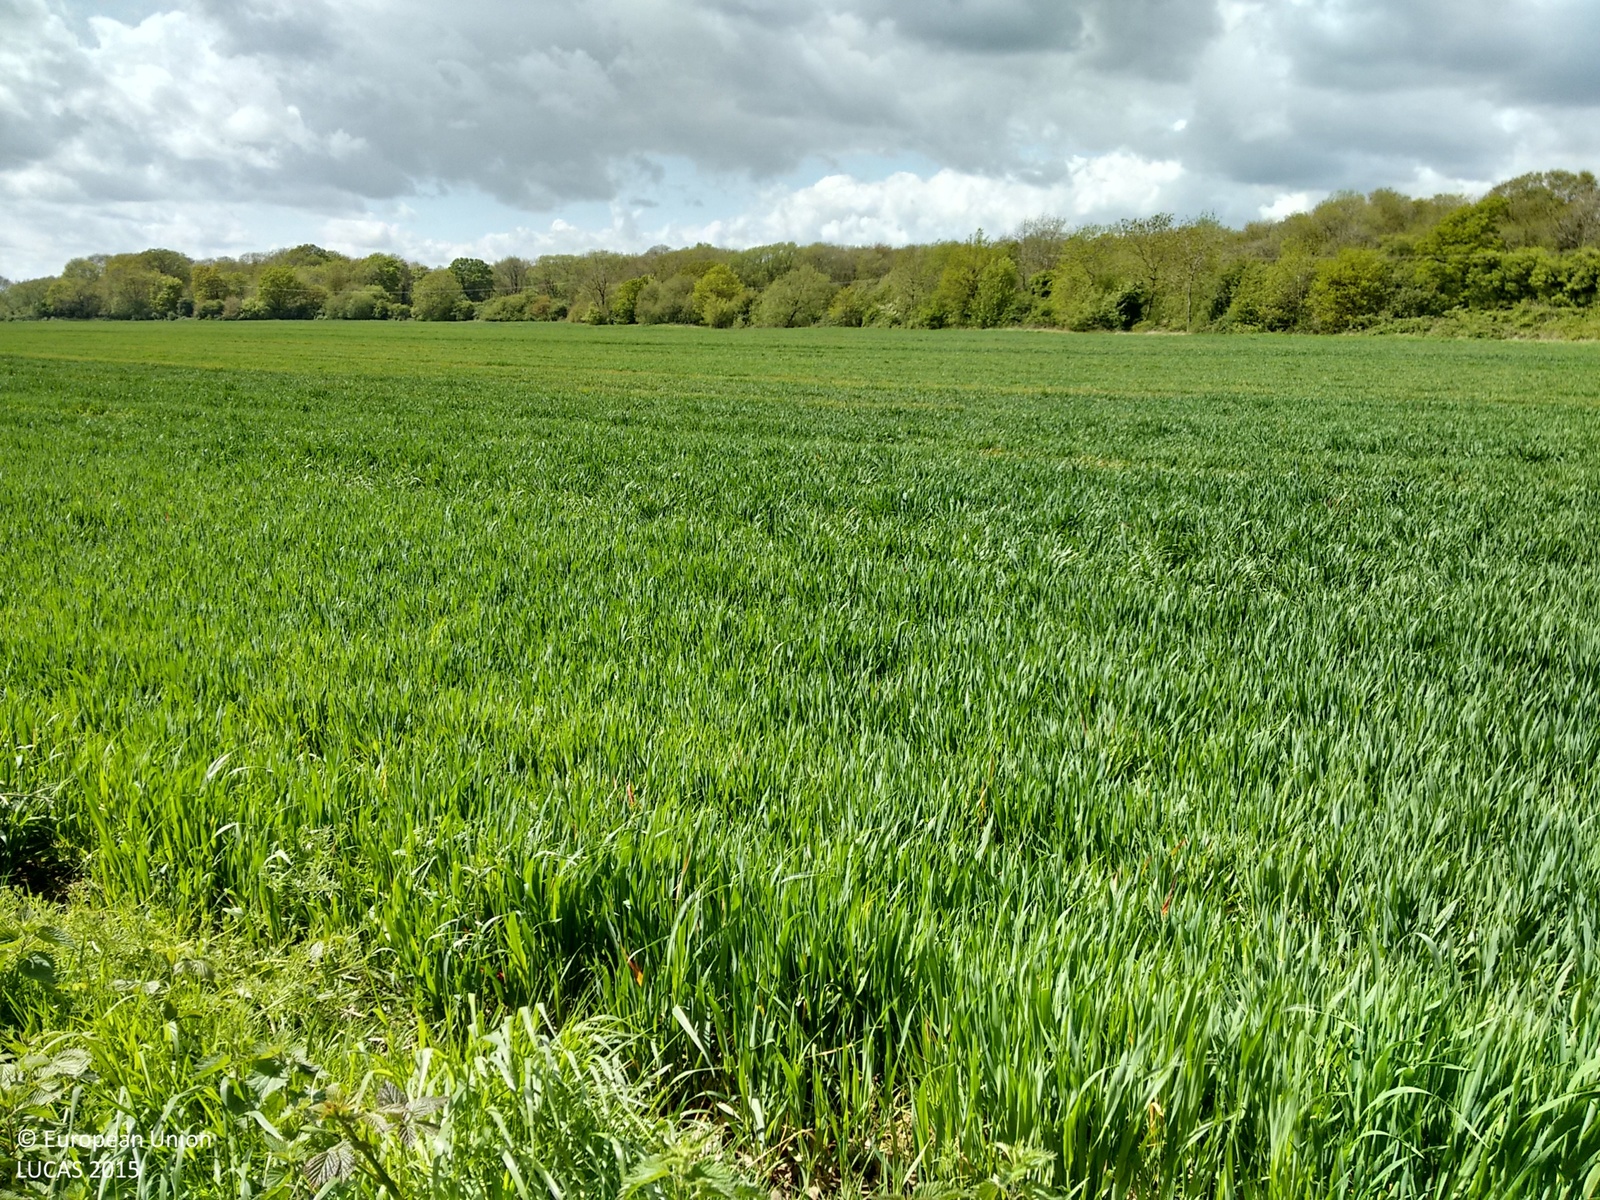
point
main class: Woodland
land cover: Broadleaved woodland
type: mesophytic deciduous forest
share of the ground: > 75 %
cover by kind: broadleaved forest trees 90 %, shrubs 10 %
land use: Semi-natural and natural areas not in use
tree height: > 5 m
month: May
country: GB
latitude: 51.1966
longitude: 0.2529
